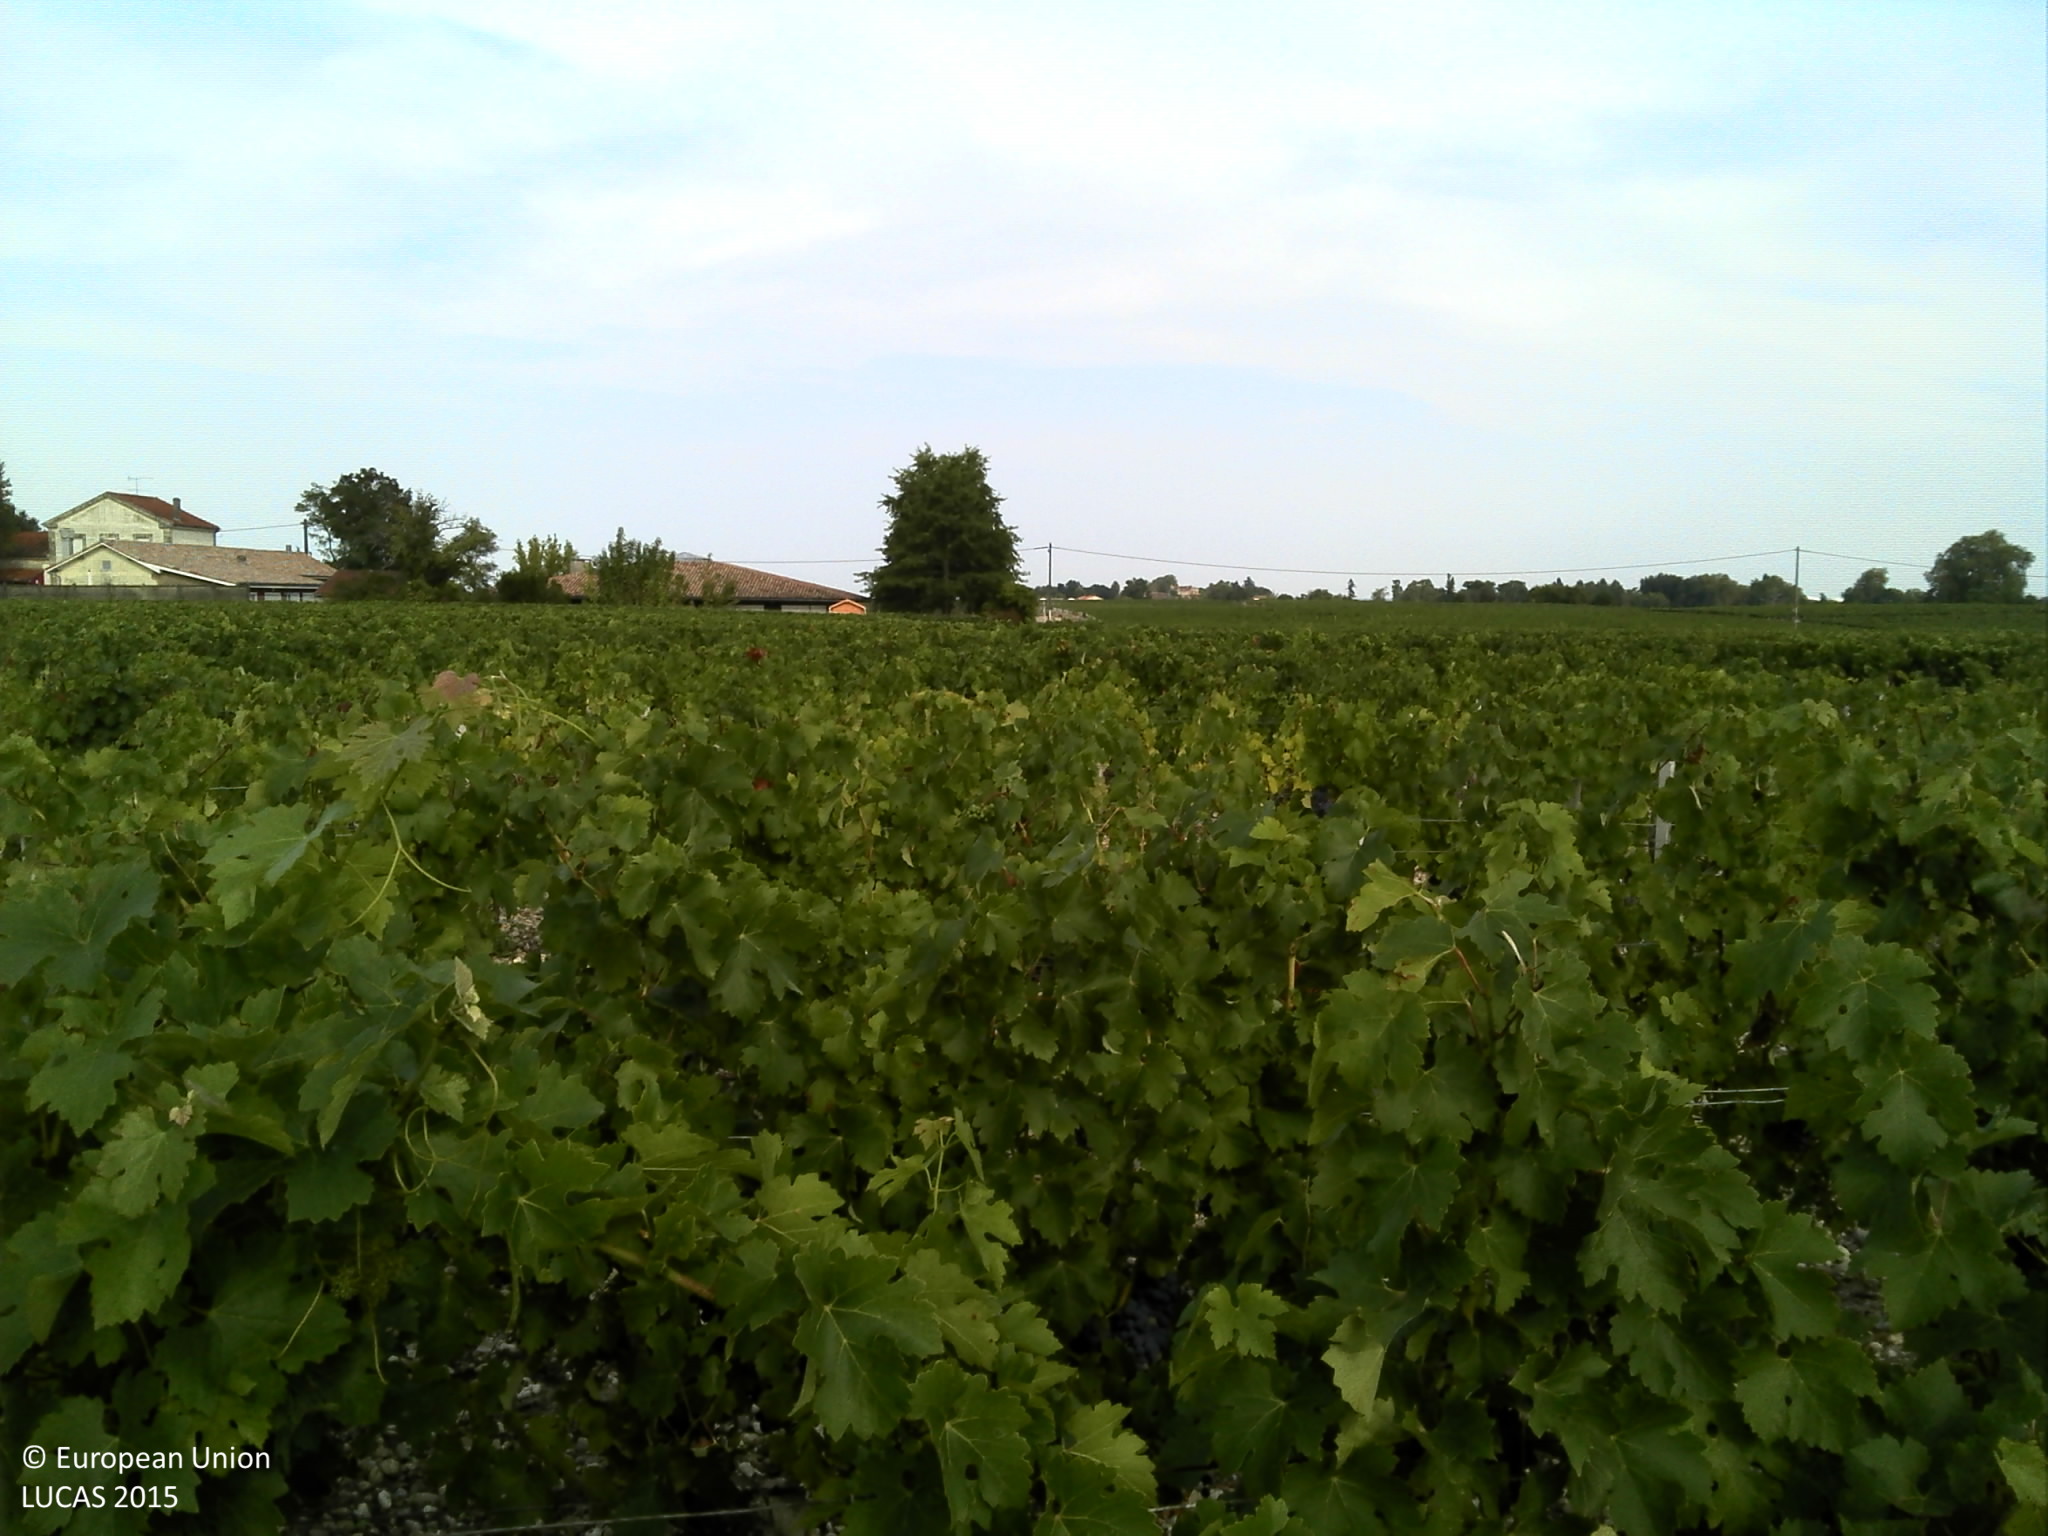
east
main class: Cropland
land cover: Vineyards
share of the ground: 25 - 50 %
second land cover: Other bare soil
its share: > 75 %
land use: Agriculture (excluding fallow land and kitchen gardens)
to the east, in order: Vineyards; Other bare soil; Tracks; Vineyards; Artificial constructions in urban areas; Grass margins; Ditches and canals; Vineyards
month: August
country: FR
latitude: 45.2408
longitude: -0.7877
